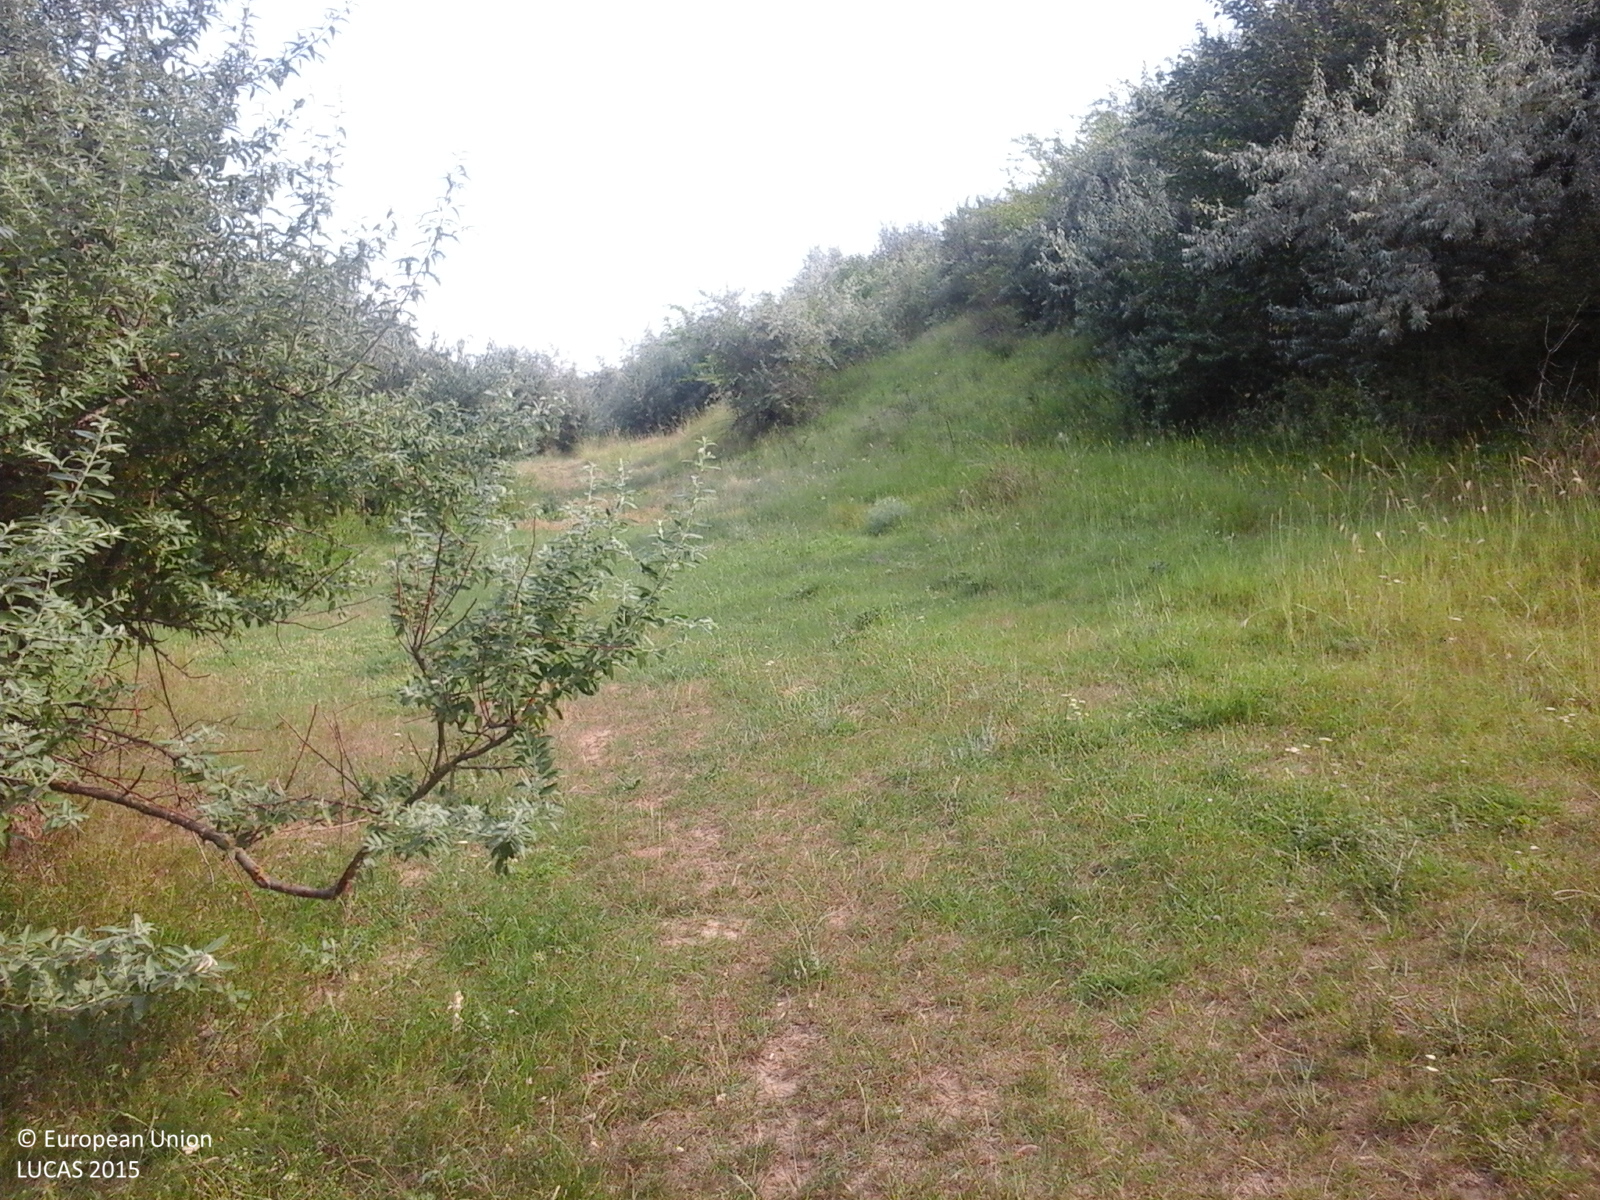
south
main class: Shrubland
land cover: Shrubland with sparse tree cover
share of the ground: > 75 %
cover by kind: herbaceous plants 80 %, shrubs 15 %, broadleaved forest trees 5 %
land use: Semi-natural and natural areas not in use
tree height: < 5 m
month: July
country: RO
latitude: 45.8874
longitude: 28.0476
